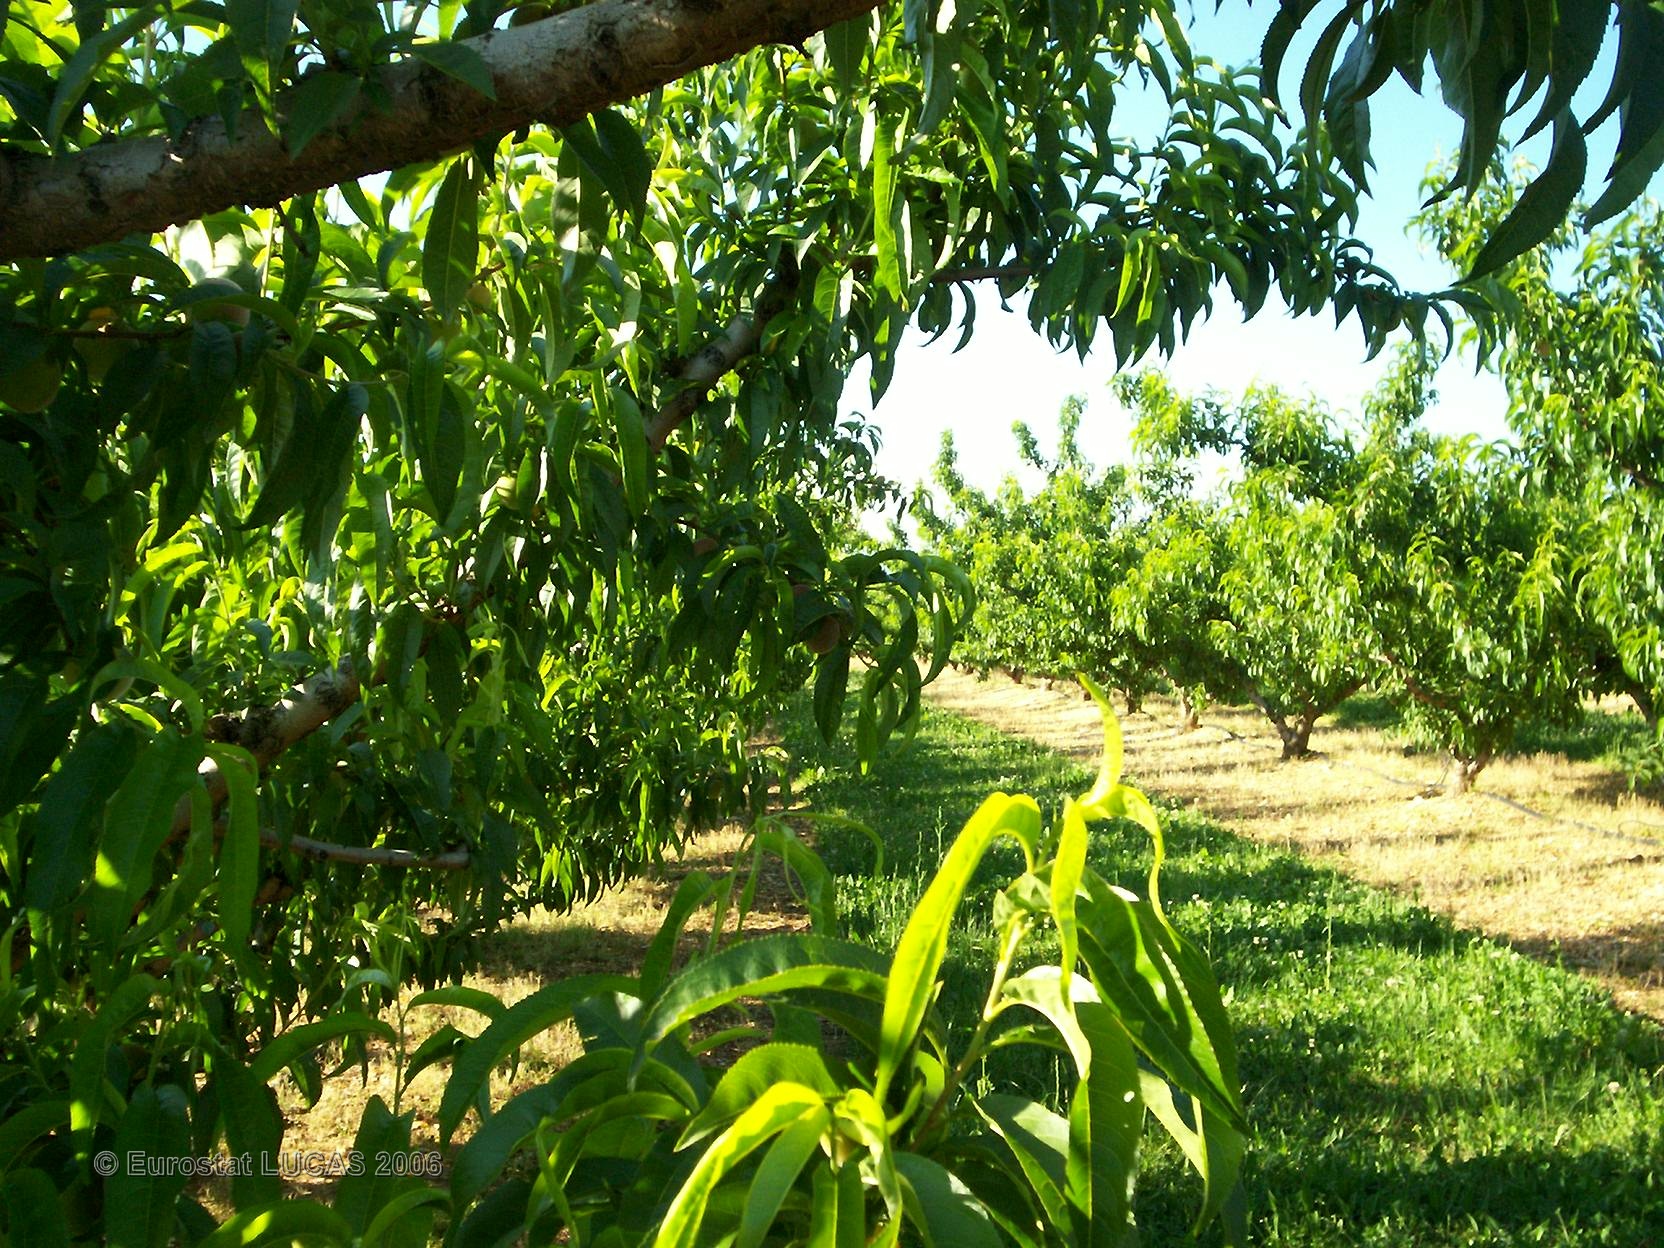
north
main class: Cropland
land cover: Other fruit trees and berries
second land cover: Grassland with sparse tree/shrub cover
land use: Agriculture (excluding fallow land and kitchen gardens)
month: May
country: FR
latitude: 44.6910
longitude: 4.8203
